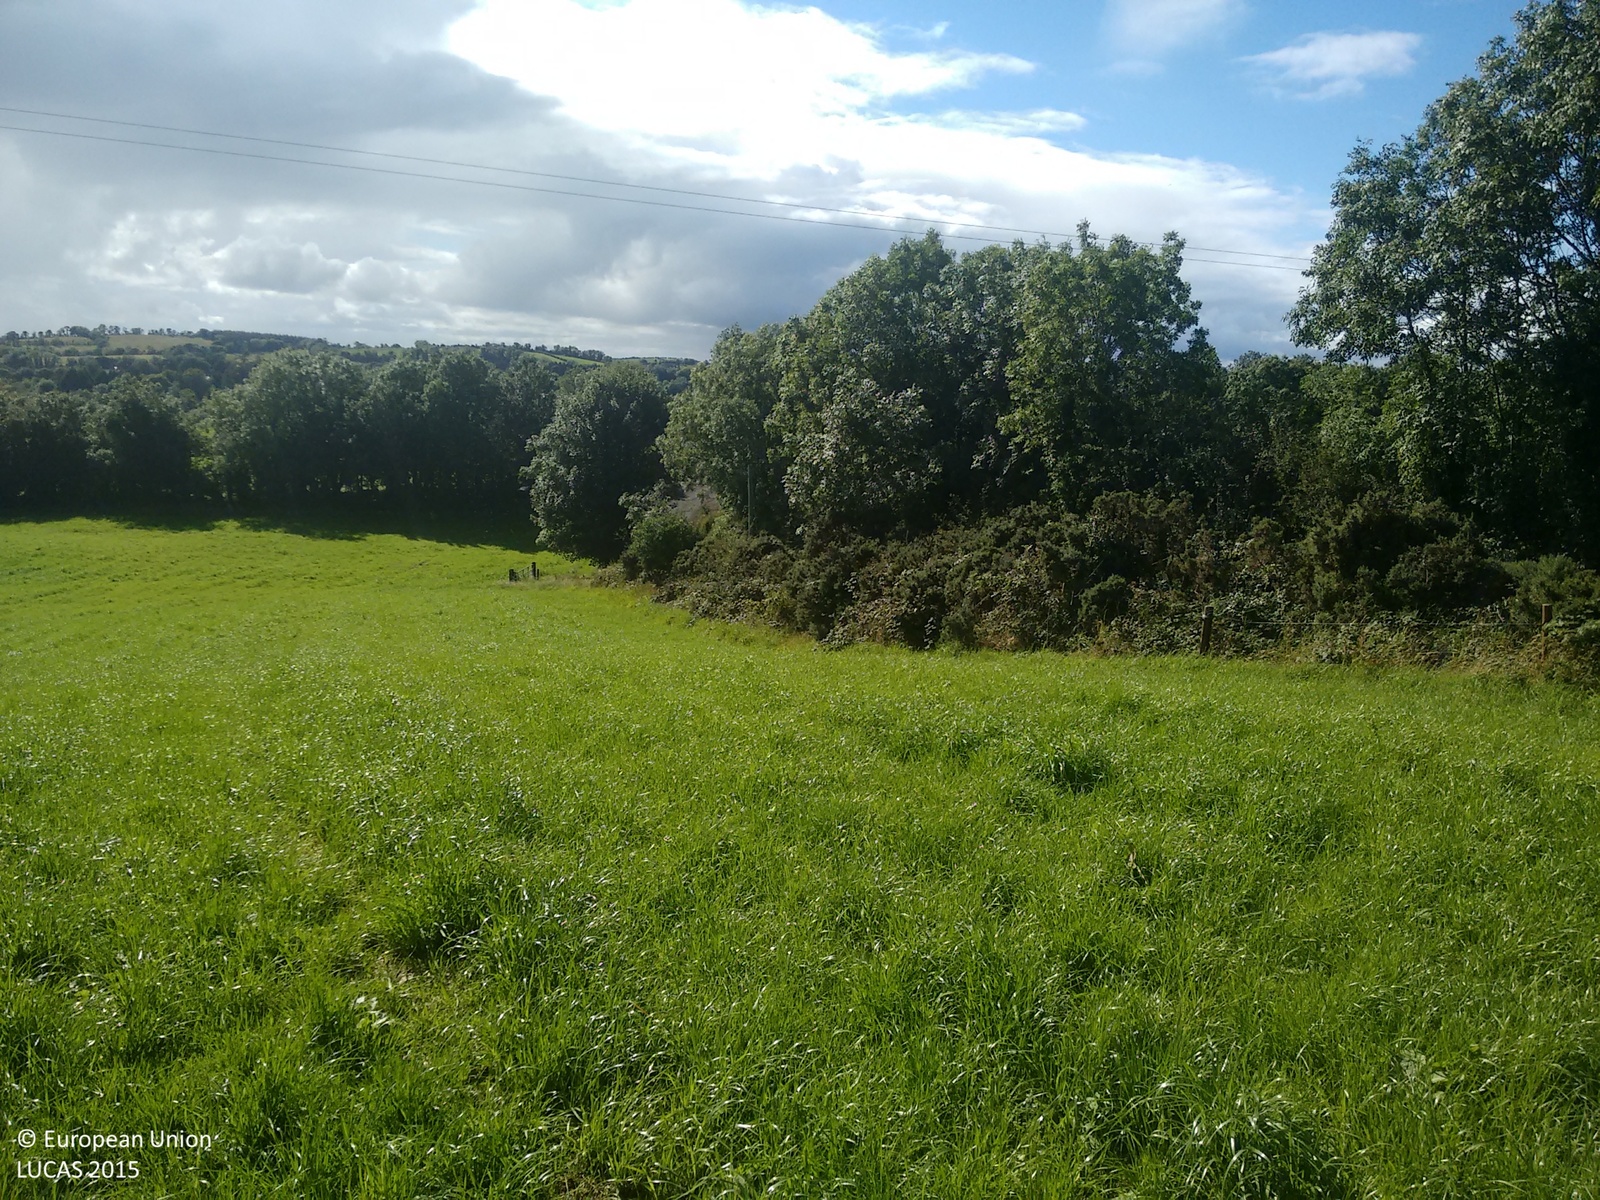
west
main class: Grassland
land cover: Grassland without tree/shrub cover
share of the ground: > 75 %
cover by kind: herbaceous plants 100 %
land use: Agriculture (excluding fallow land and kitchen gardens)
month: September
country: IE
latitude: 53.8965
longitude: -7.1440
